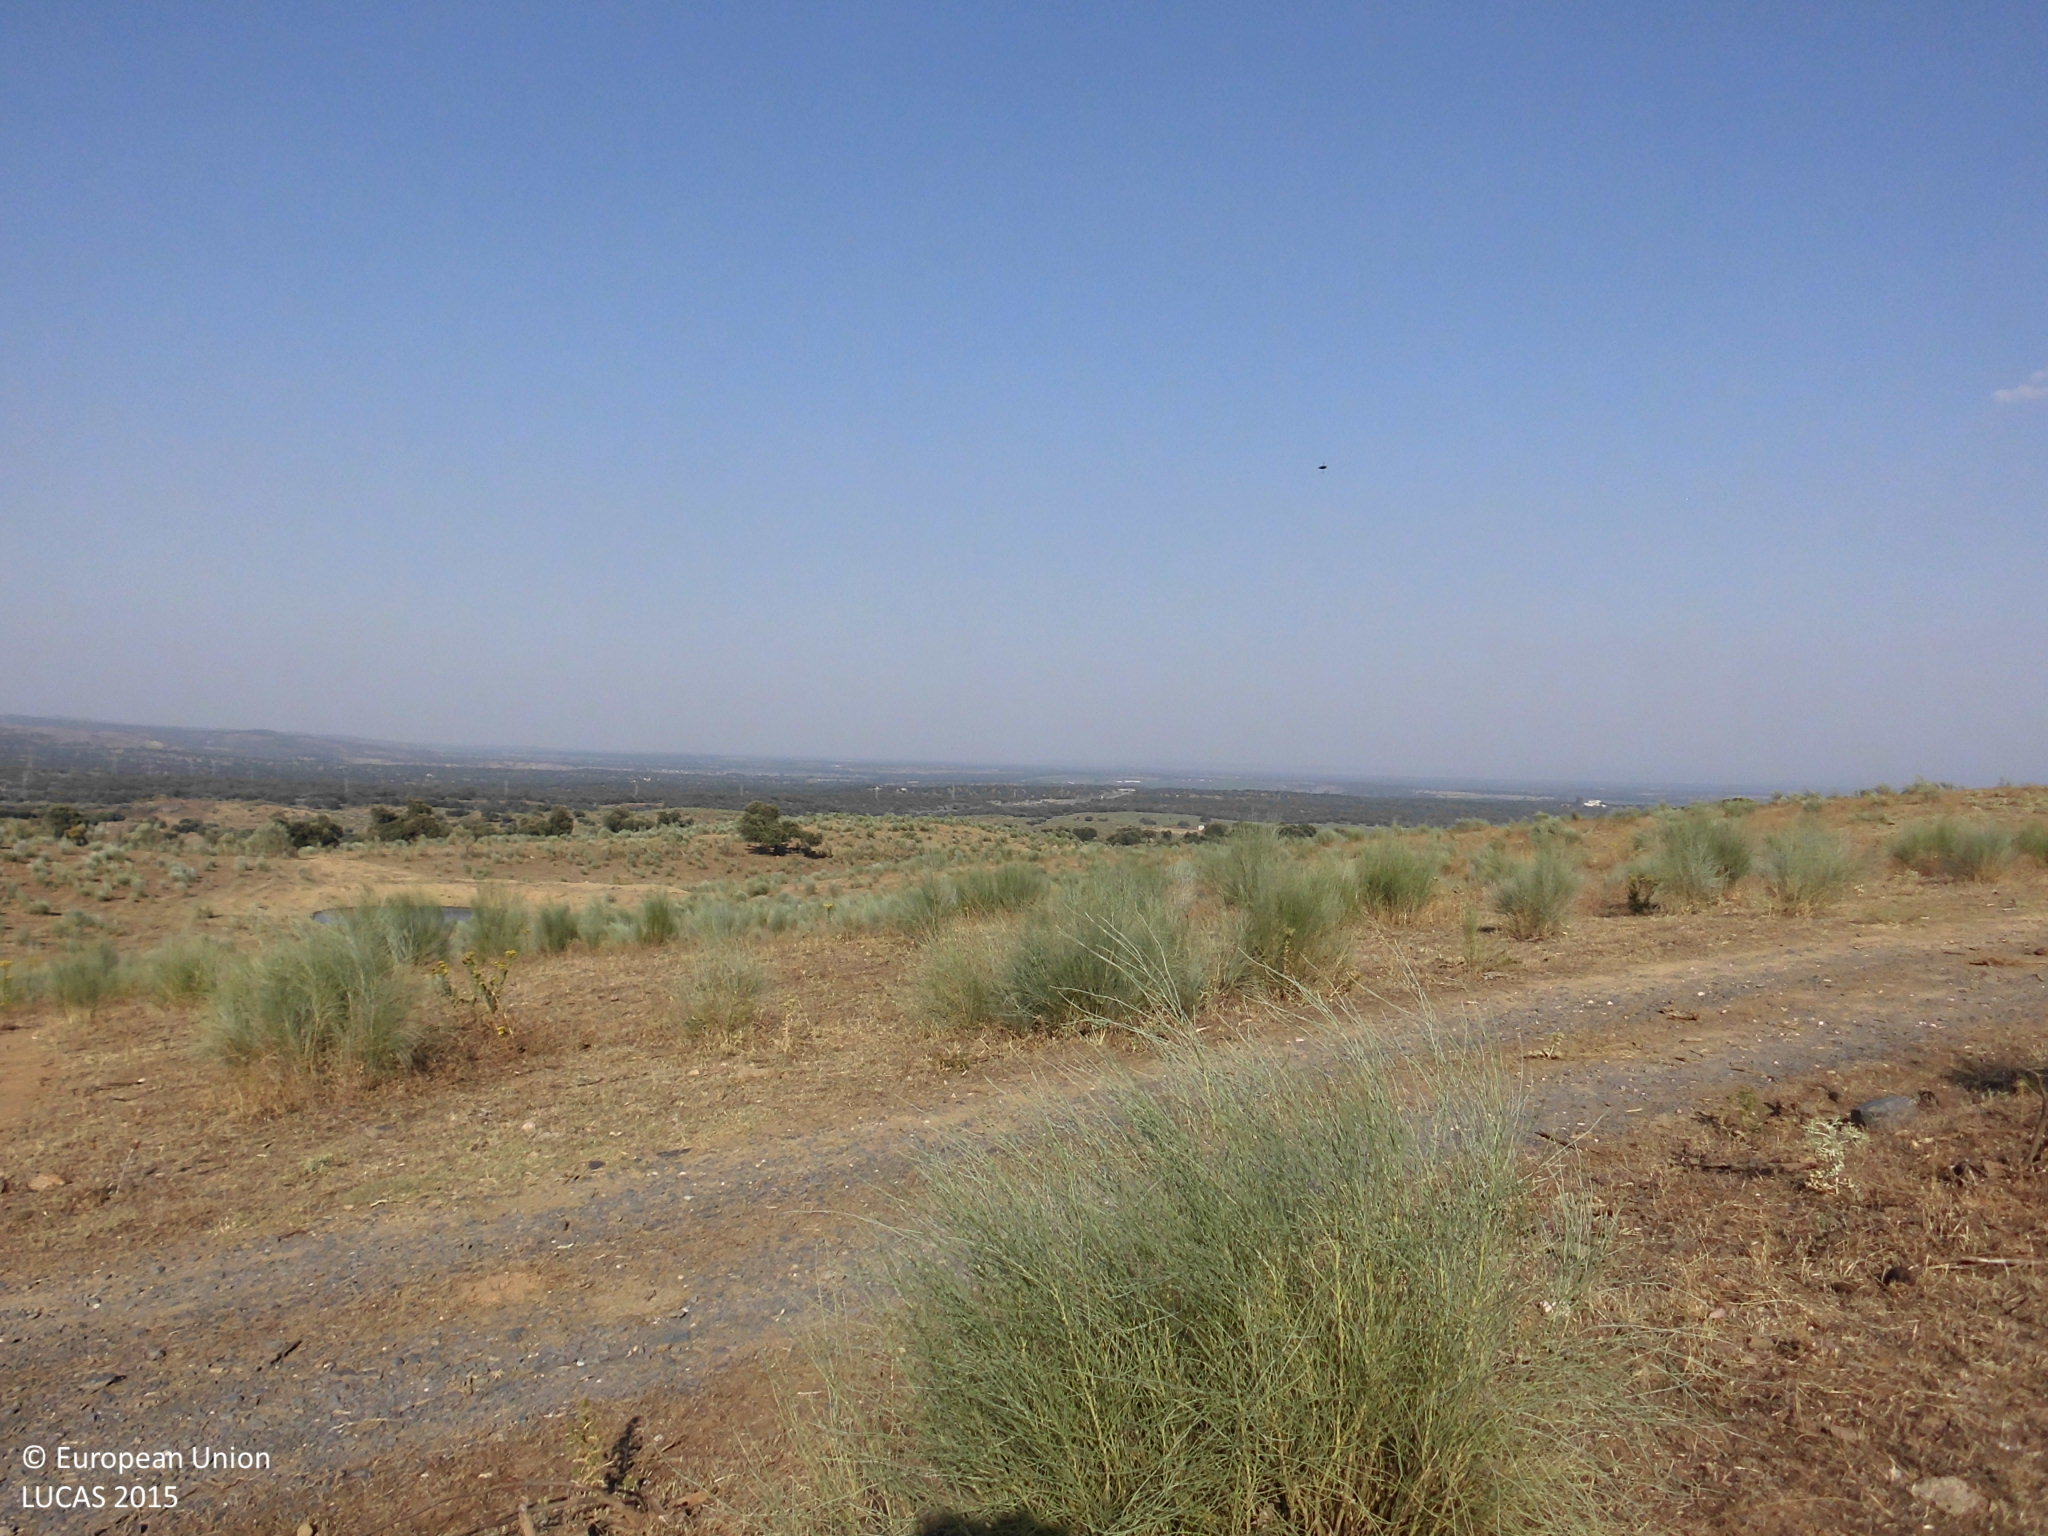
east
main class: Shrubland
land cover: Shrubland without tree cover
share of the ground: 10 - 25 %
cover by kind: herbaceous plants 70 %, shrubs 25 %, unconsolidated bare surface 5 %
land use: Agriculture (excluding fallow land and kitchen gardens)
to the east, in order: Shrubland without tree cover; Tracks; Shrubland without tree cover; Tracks; Shrubland without tree cover; Fences; Single bushes/trees; Shrubland without tree cover; Tracks; Shrubland without tree cover
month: June
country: ES
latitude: 39.9567
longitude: -6.0002
